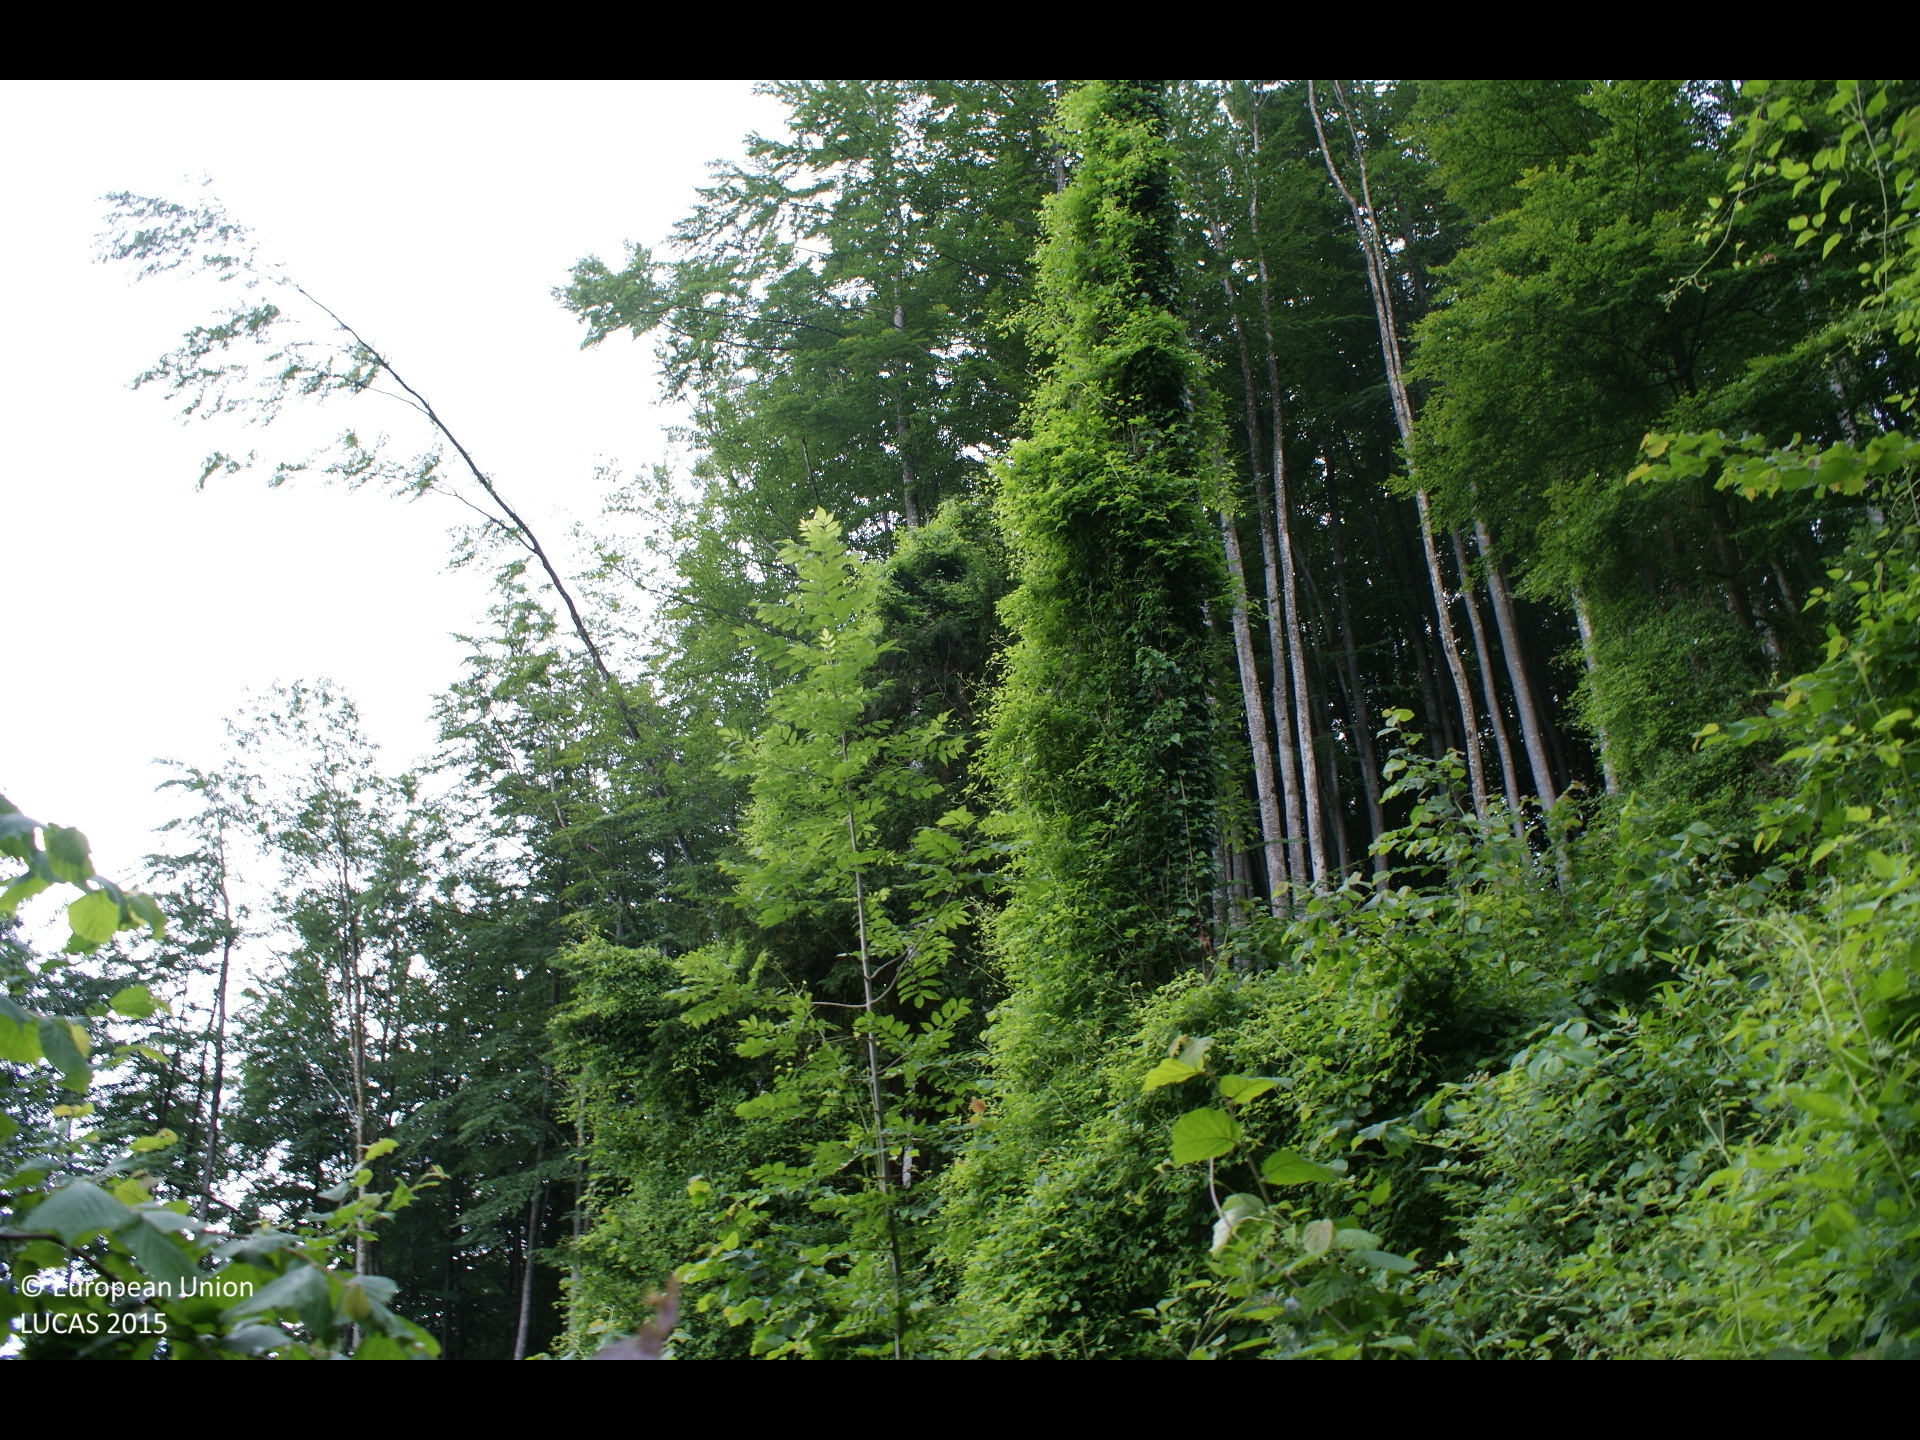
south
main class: Shrubland
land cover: Shrubland with sparse tree cover
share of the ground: > 75 %
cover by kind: shrubs 75 %, herbaceous plants 20 %, broadleaved forest trees 5 %
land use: Forestry
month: June
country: AT
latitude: 47.9553
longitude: 14.4055
